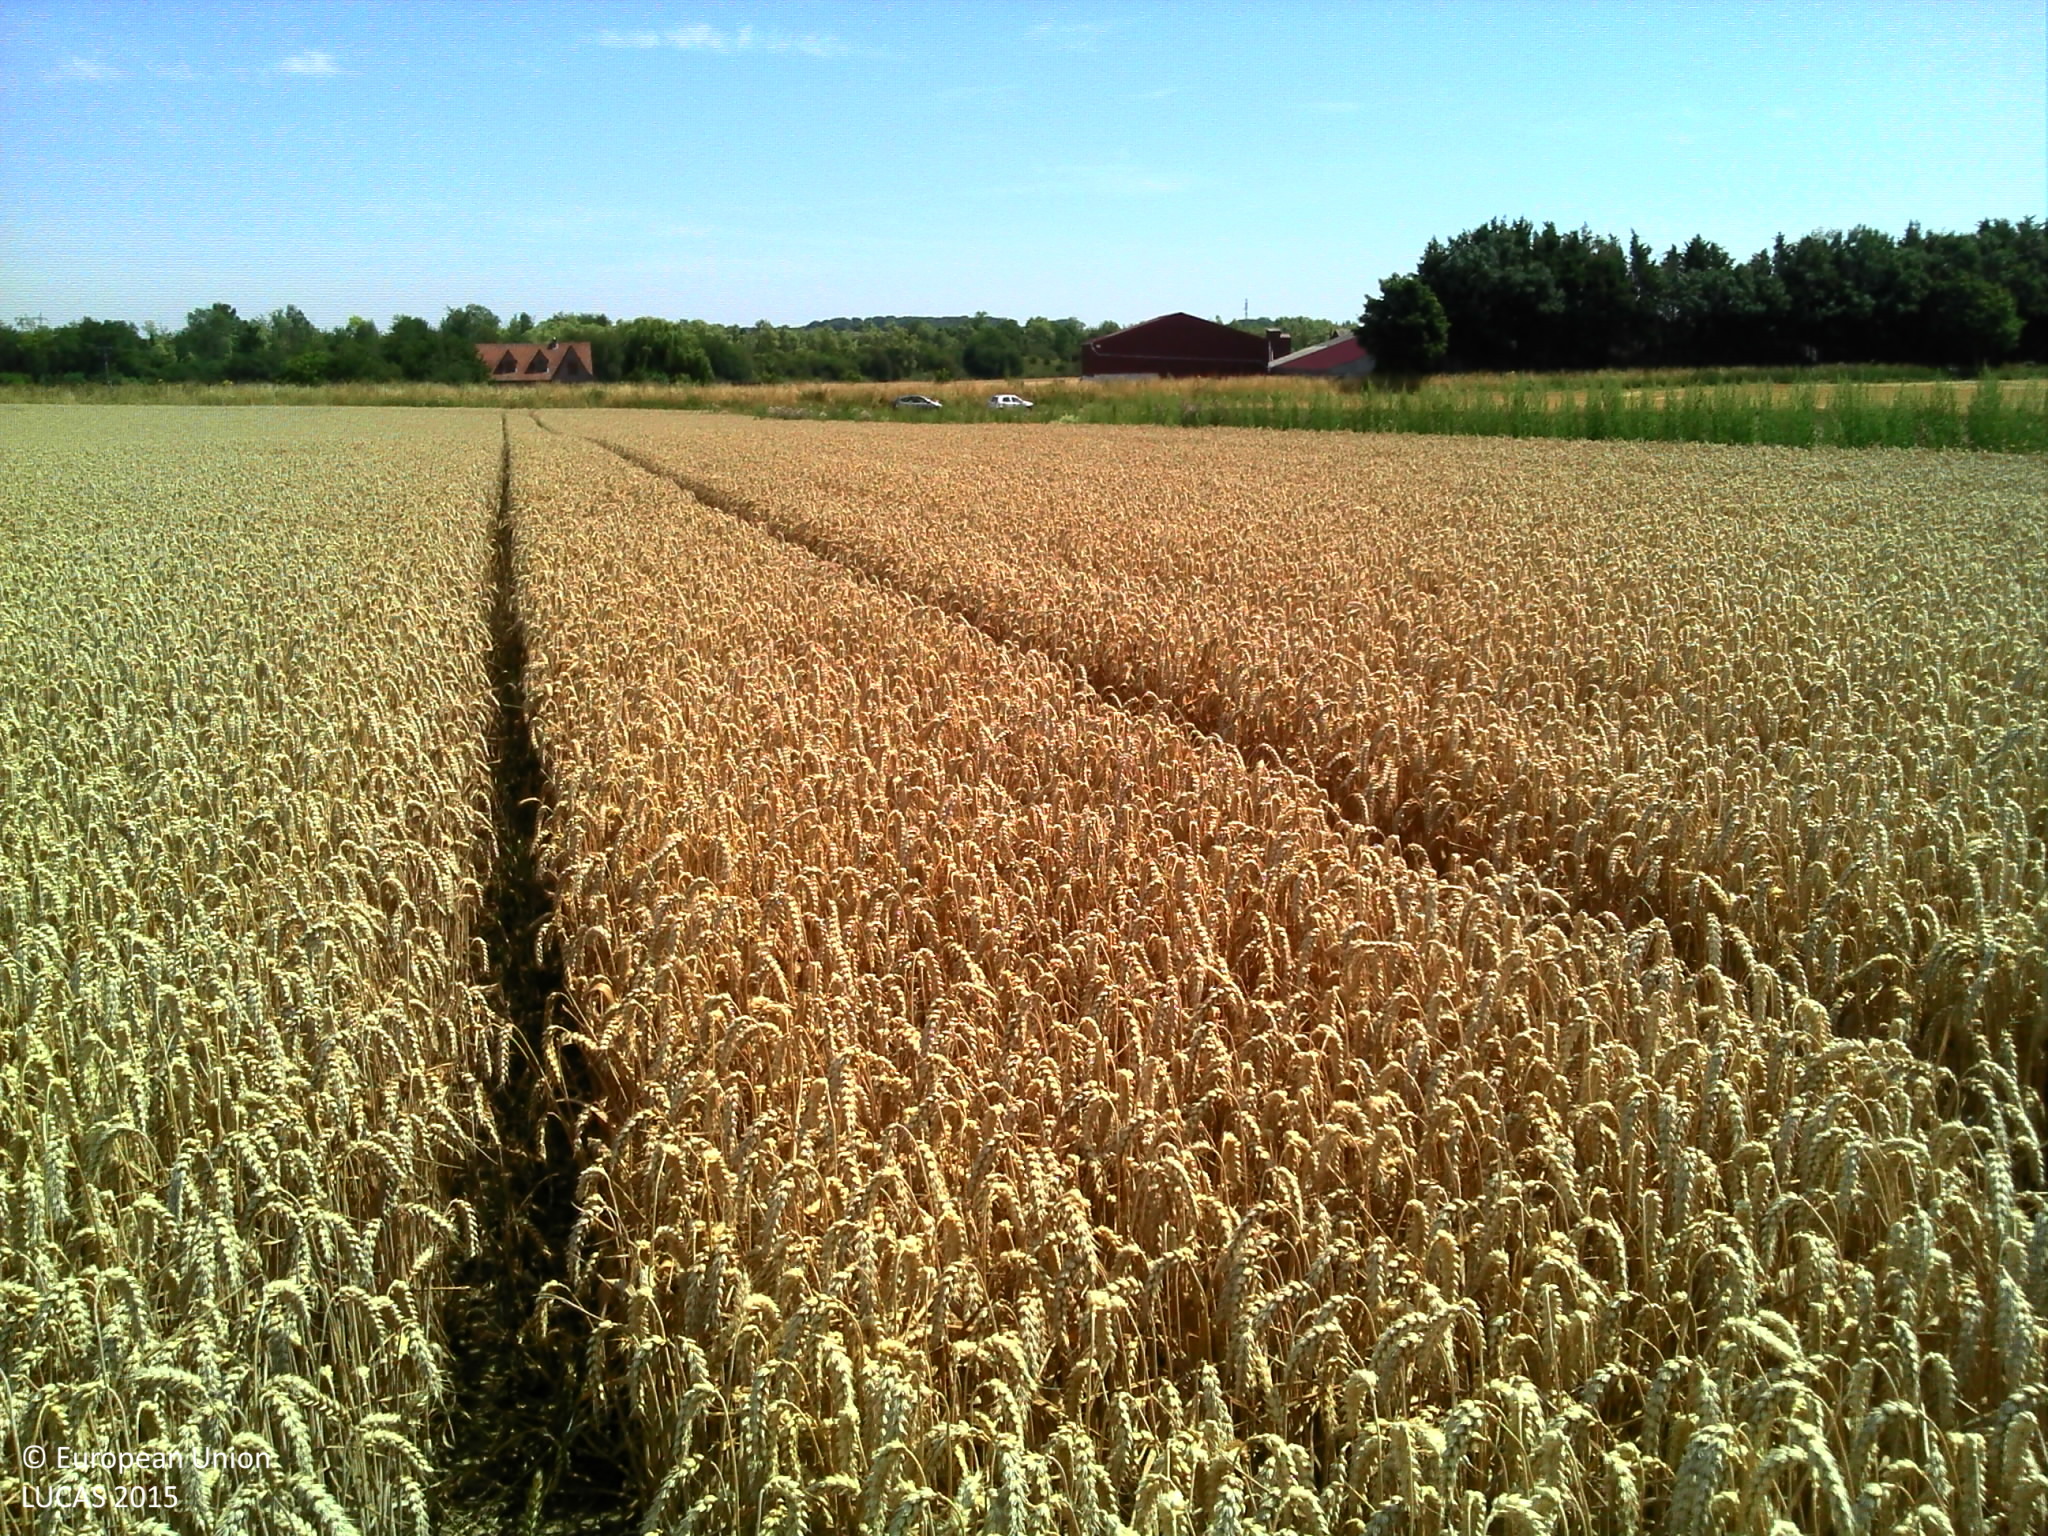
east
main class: Cropland
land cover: Common wheat
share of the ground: > 75 %
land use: Agriculture (excluding fallow land and kitchen gardens)
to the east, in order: Common wheat; Tracks; Grass margins; Ditches and canals; Grass margins; Paved roads, cycling and walking lanes; Grass margins; Ditches and canals; Grass margins; Common wheat
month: August
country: FR
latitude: 50.2998
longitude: 3.0975
